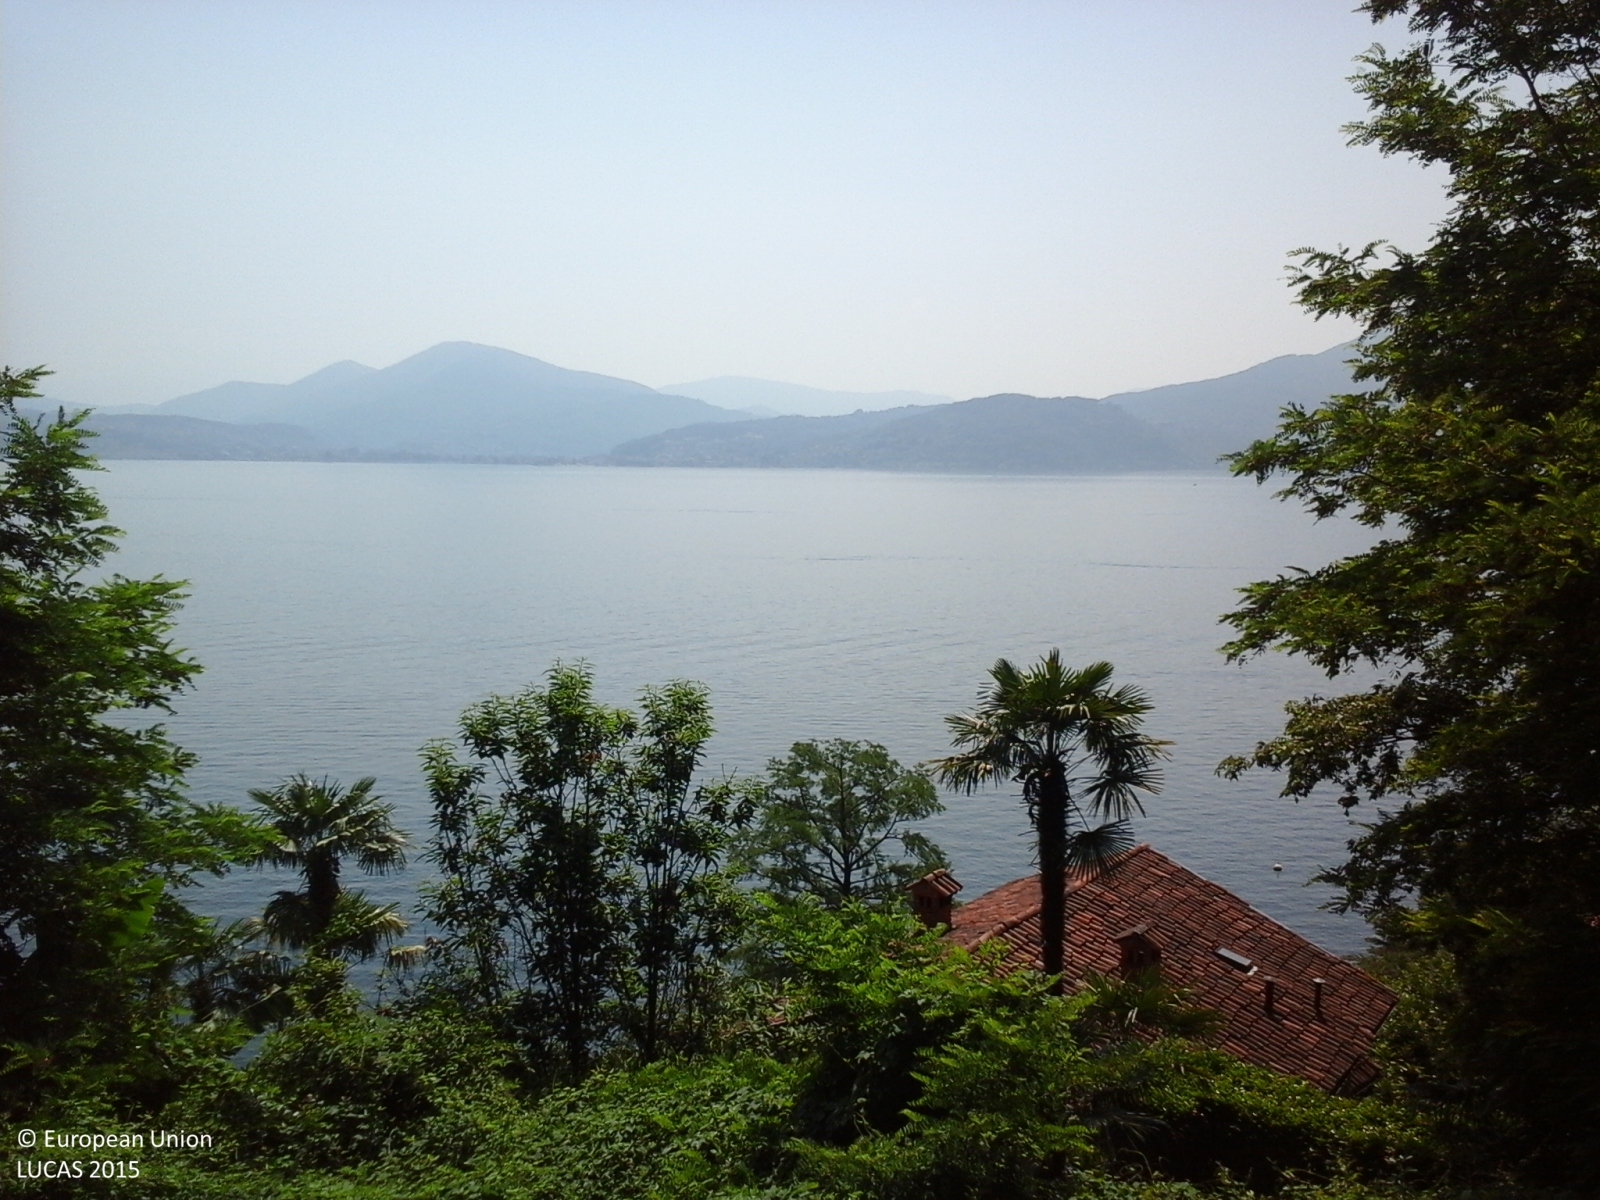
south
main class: Woodland
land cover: Other mixed woodland
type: thermophilous deciduous forest
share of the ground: > 75 %
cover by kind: broadleaved forest trees 75 %, coniferous forest trees 25 %
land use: Forestry
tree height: > 5 m
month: June
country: IT
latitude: 46.0187
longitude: 8.6715
